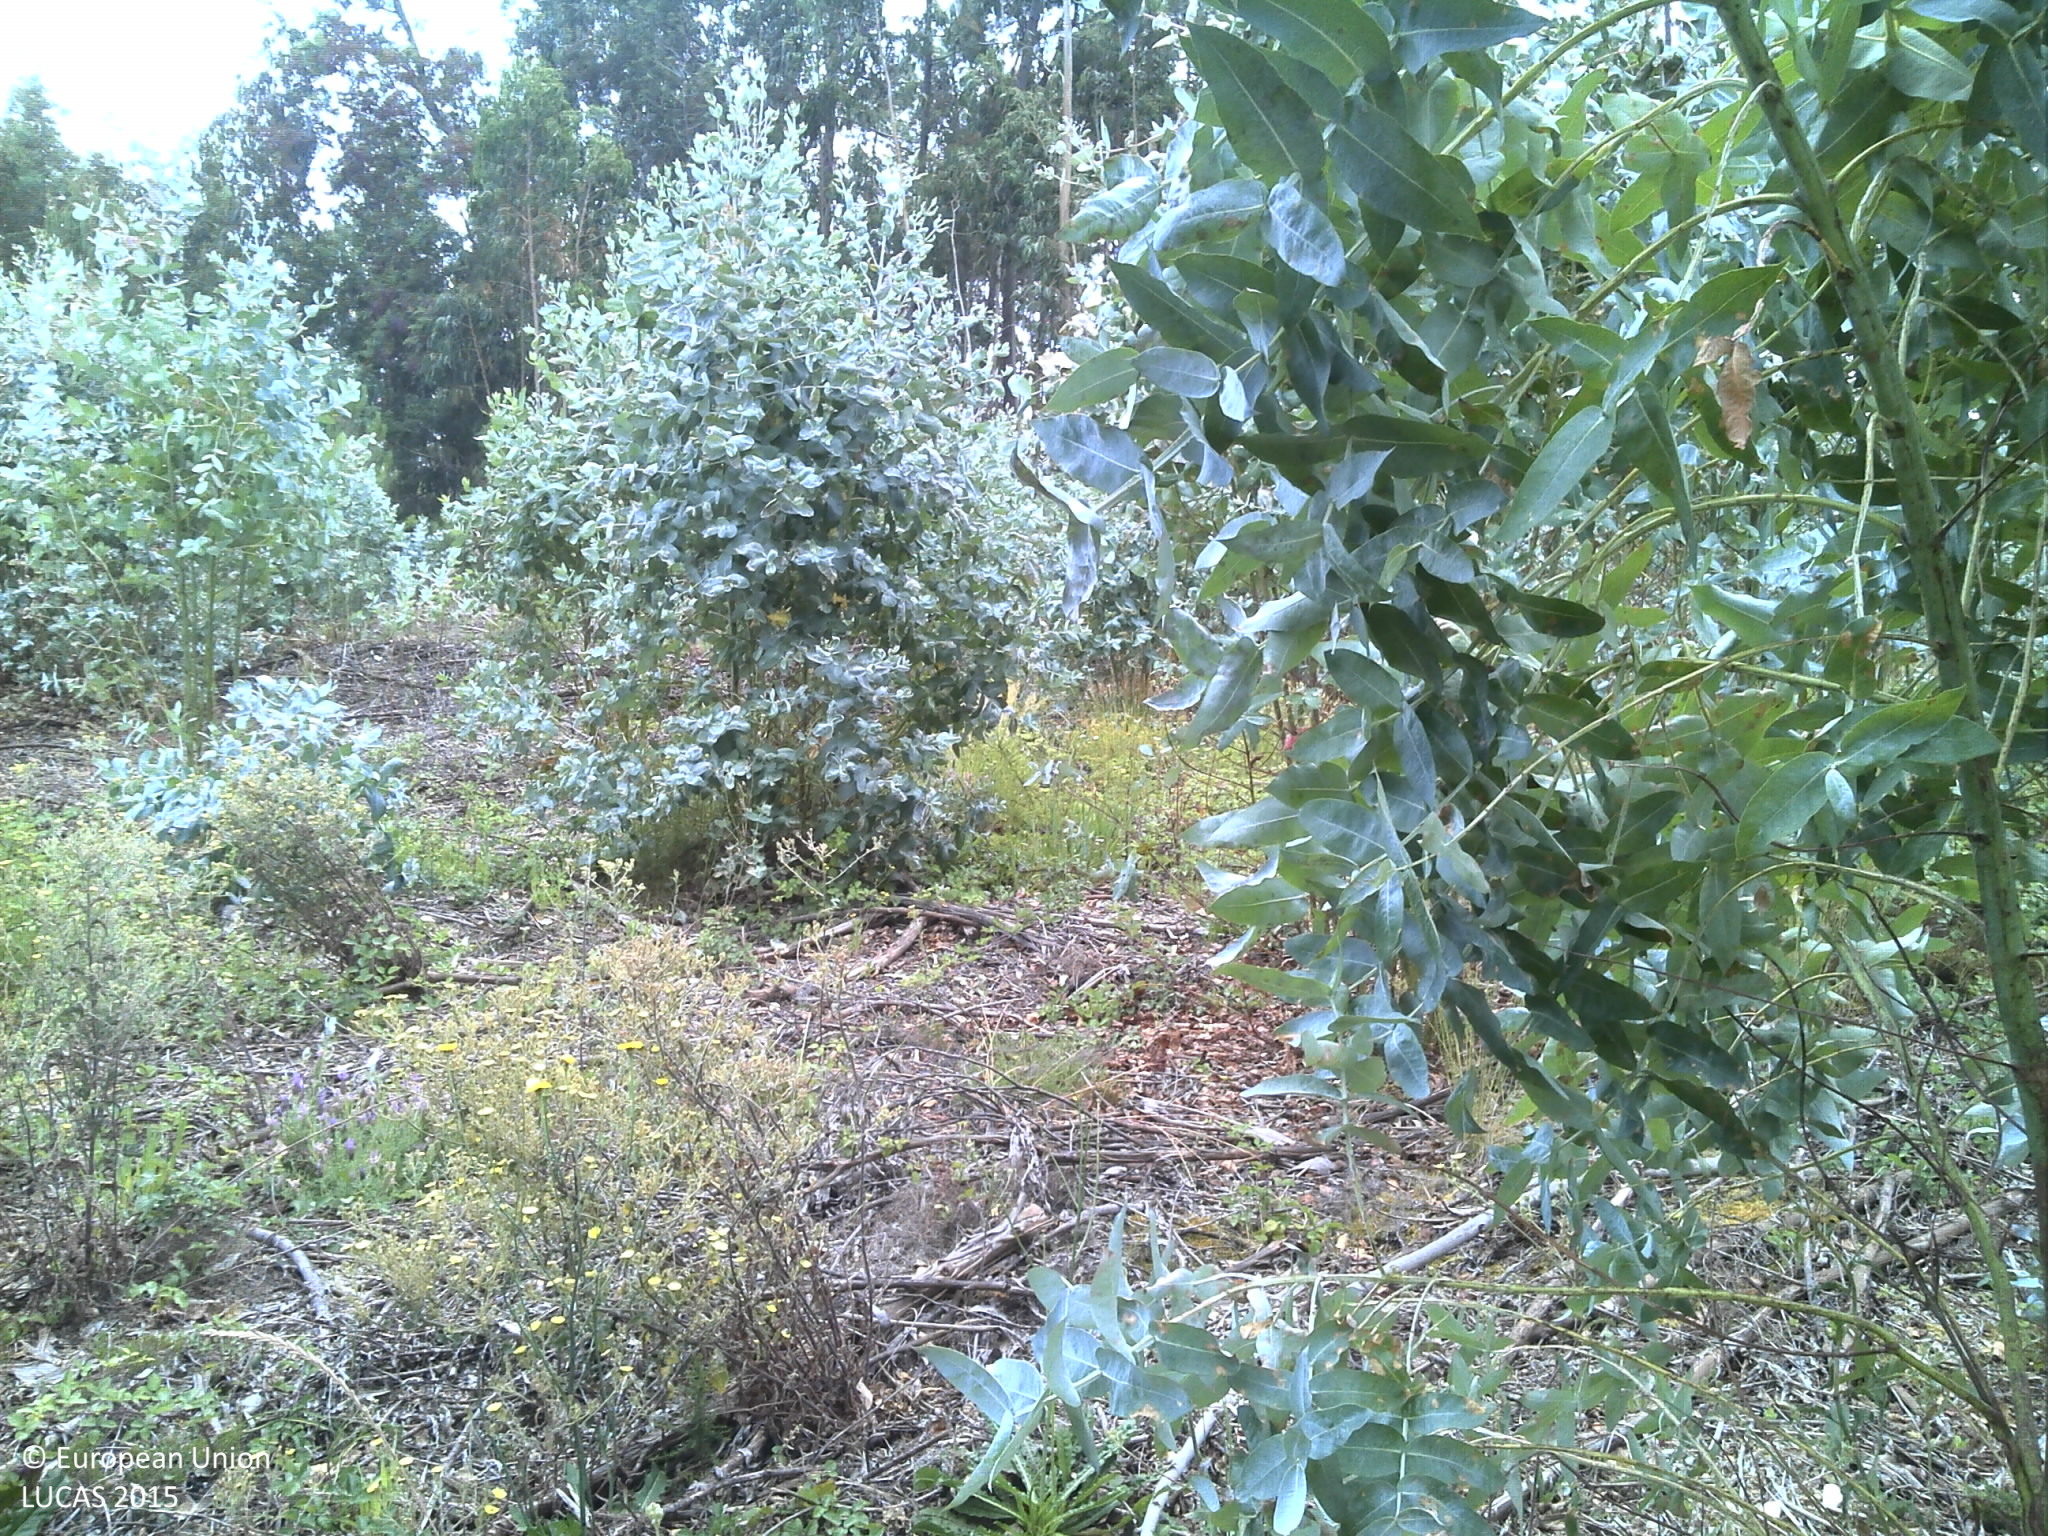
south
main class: Woodland
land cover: Broadleaved woodland
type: exotic forest
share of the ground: 50 - 75 %
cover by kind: broadleaved forest trees 60 %, shrubs 25 %, unconsolidated bare surface 10 %, herbaceous plants 5 %
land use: Forestry
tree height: > 5 m
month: June
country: PT
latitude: 40.2595
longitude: -8.6325
